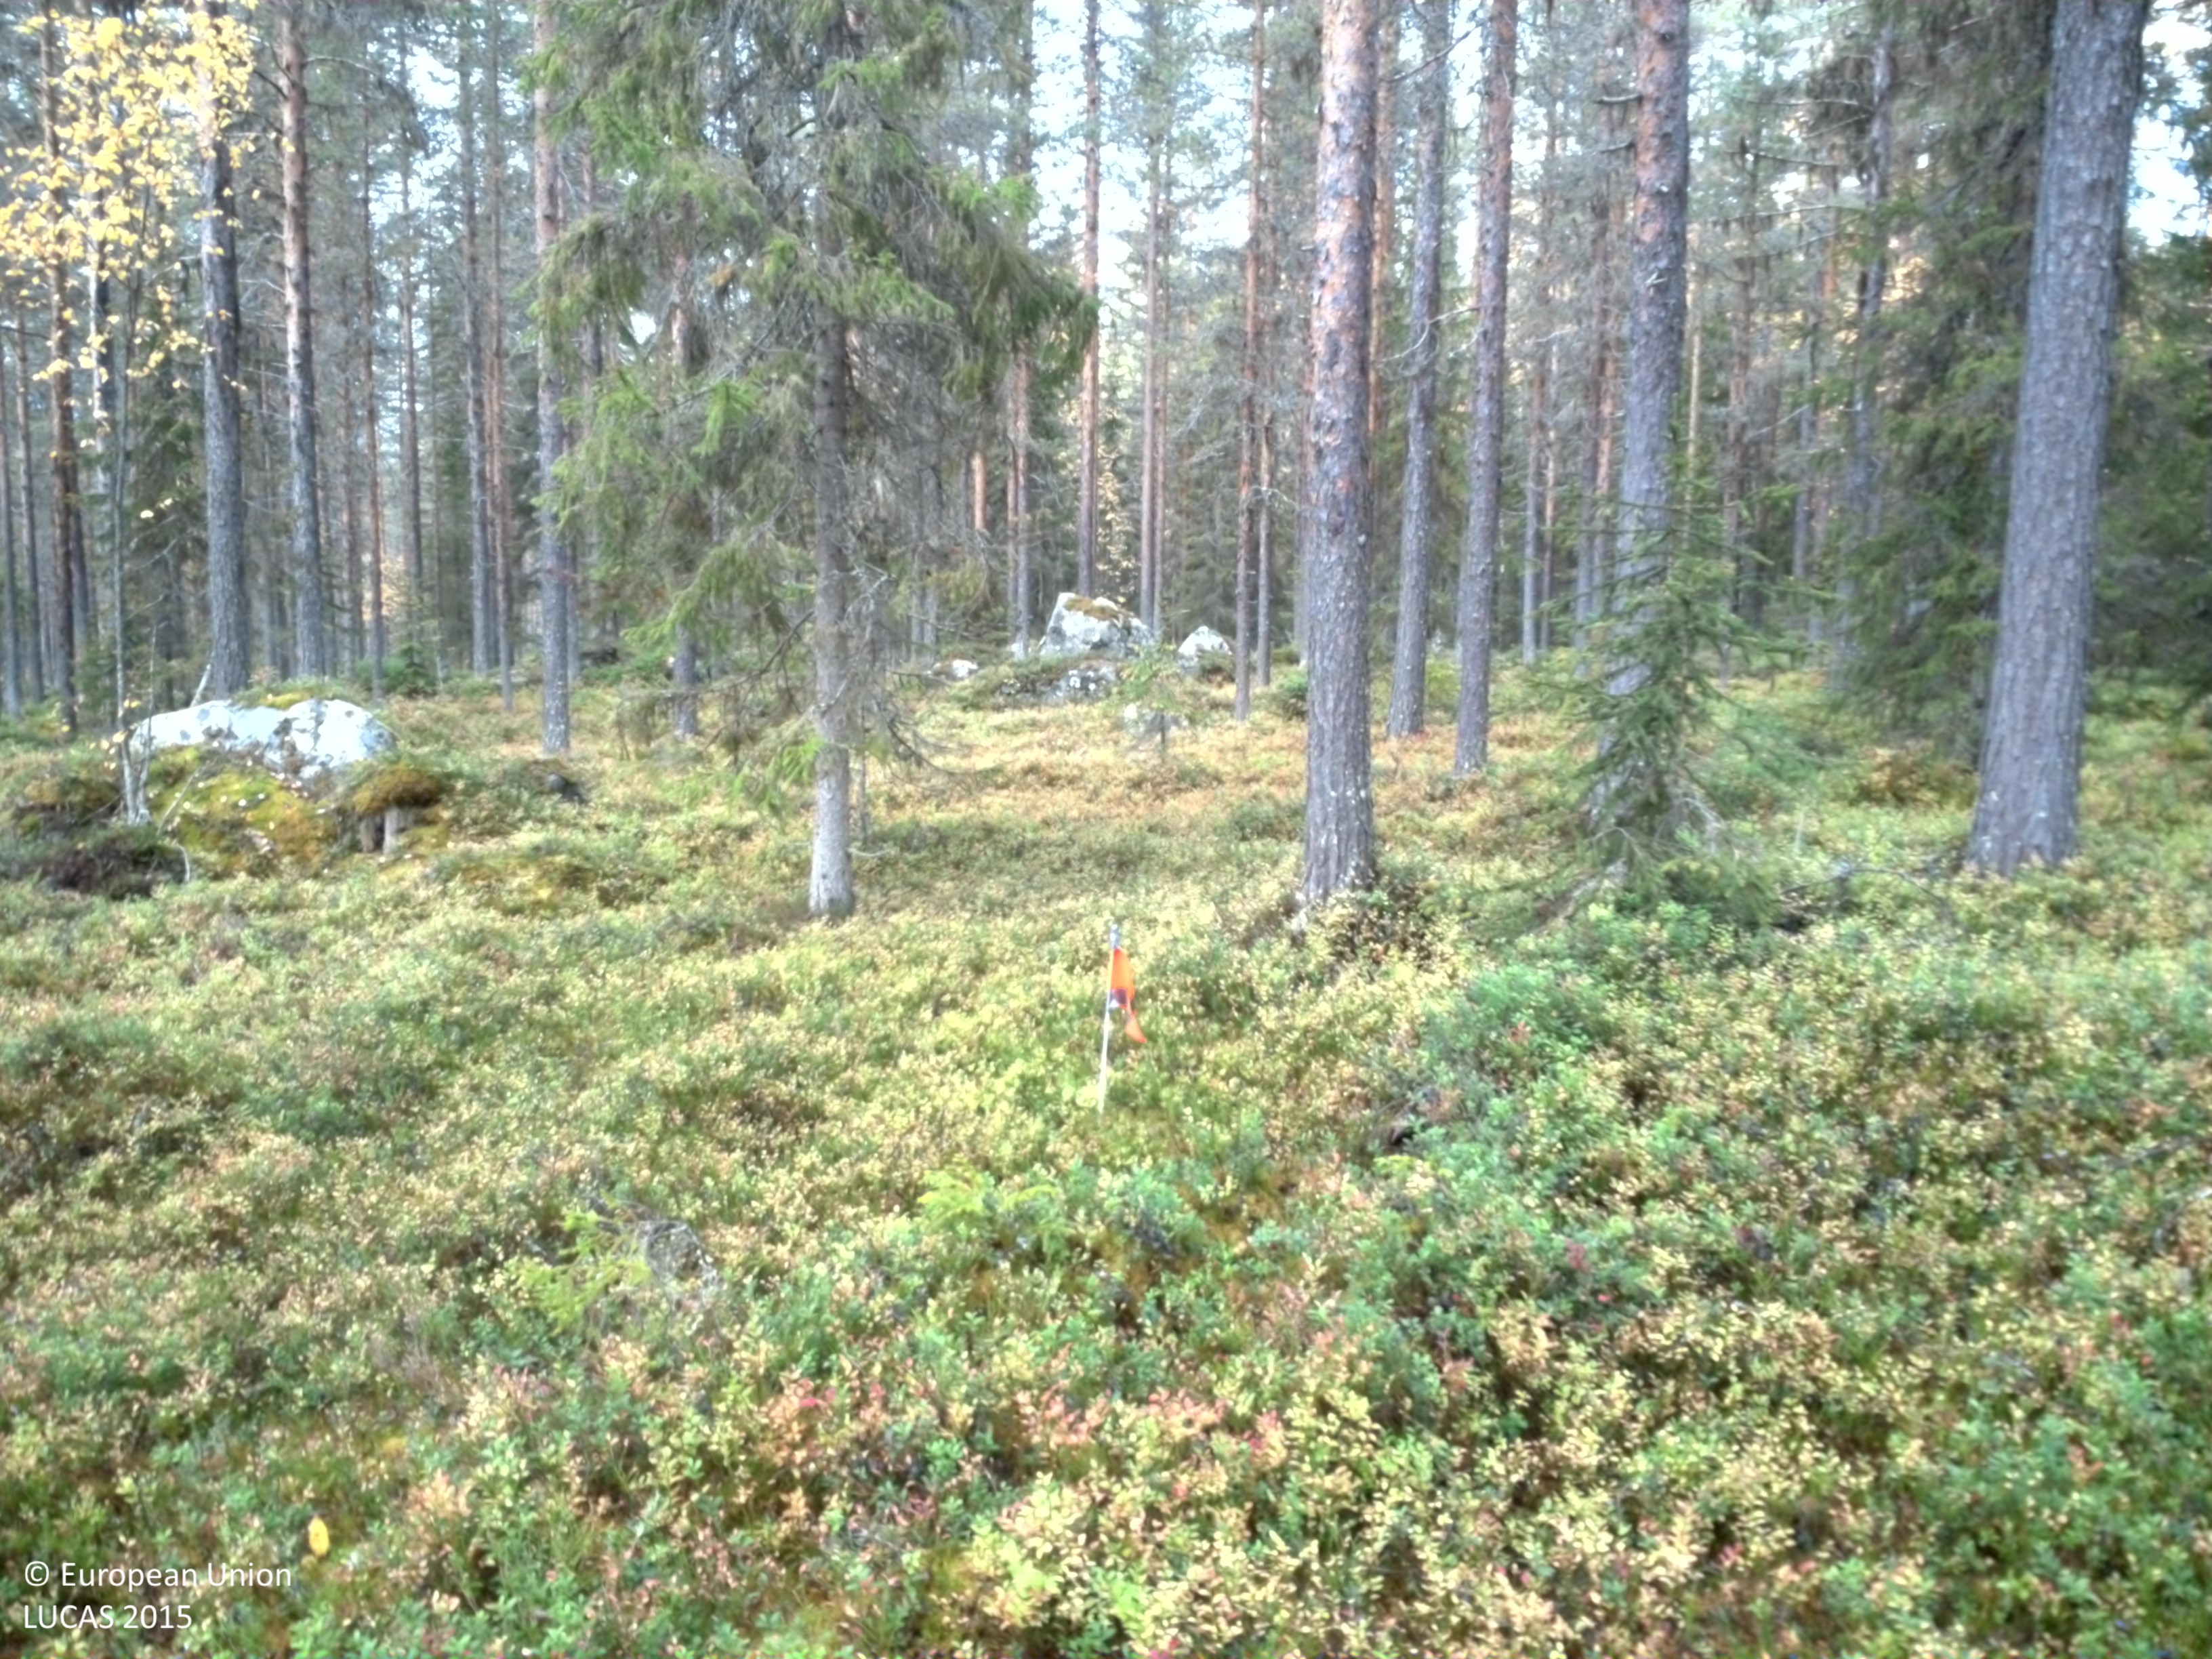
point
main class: Woodland
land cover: Pine dominated coniferous woodland
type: boreal forest
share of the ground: 25 - 50 %
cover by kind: shrubs 45 %, coniferous forest trees 35 %, lichens and mosses 20 %
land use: Forestry
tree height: > 5 m
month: September
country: SE
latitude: 65.1254
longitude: 17.5691
